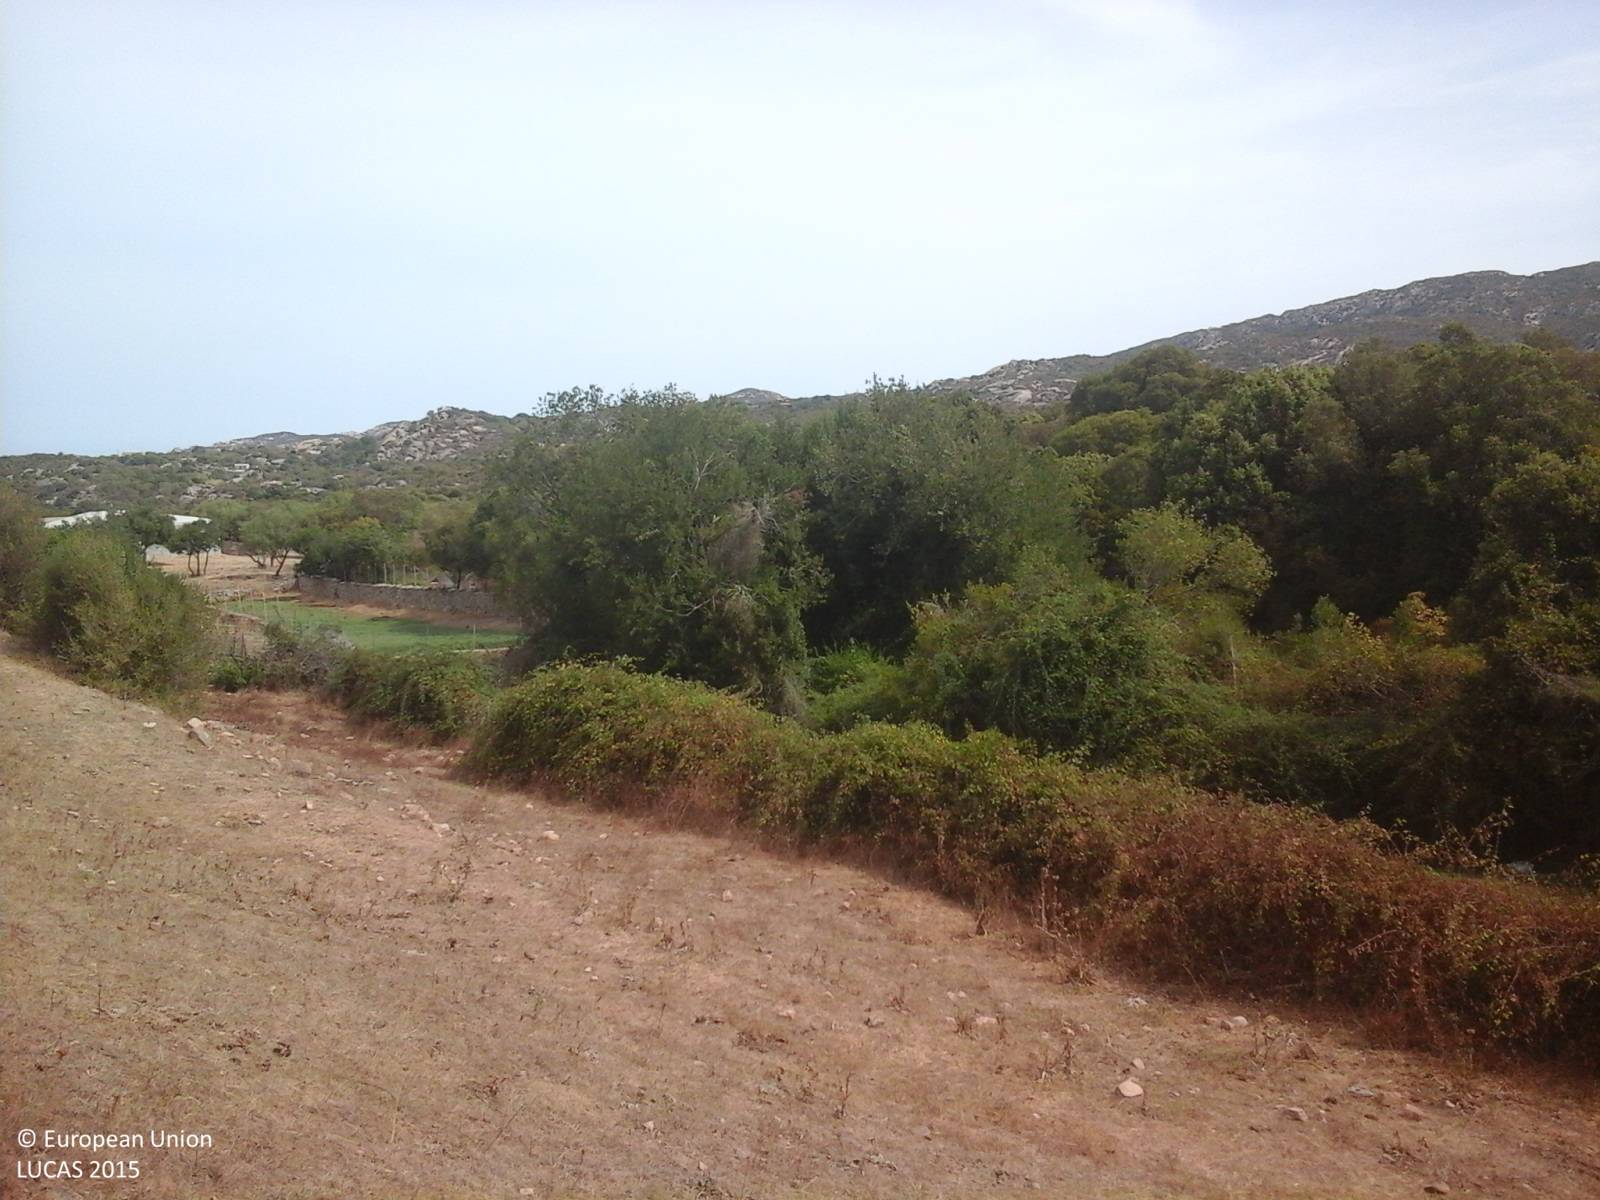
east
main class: Grassland
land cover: Grassland without tree/shrub cover
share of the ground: > 75 %
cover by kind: herbaceous plants 95 %, unconsolidated bare surface 5 %
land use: Agriculture (excluding fallow land and kitchen gardens)
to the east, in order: Grassland without tree/shrub cover; Electric lines; Abandoned hedges; Shrubland without tree cover; Broadleaved woodland; Shrubland without tree cover; Shrubland with sparse tree cover
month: September
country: IT
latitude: 41.0983
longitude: 9.4667
